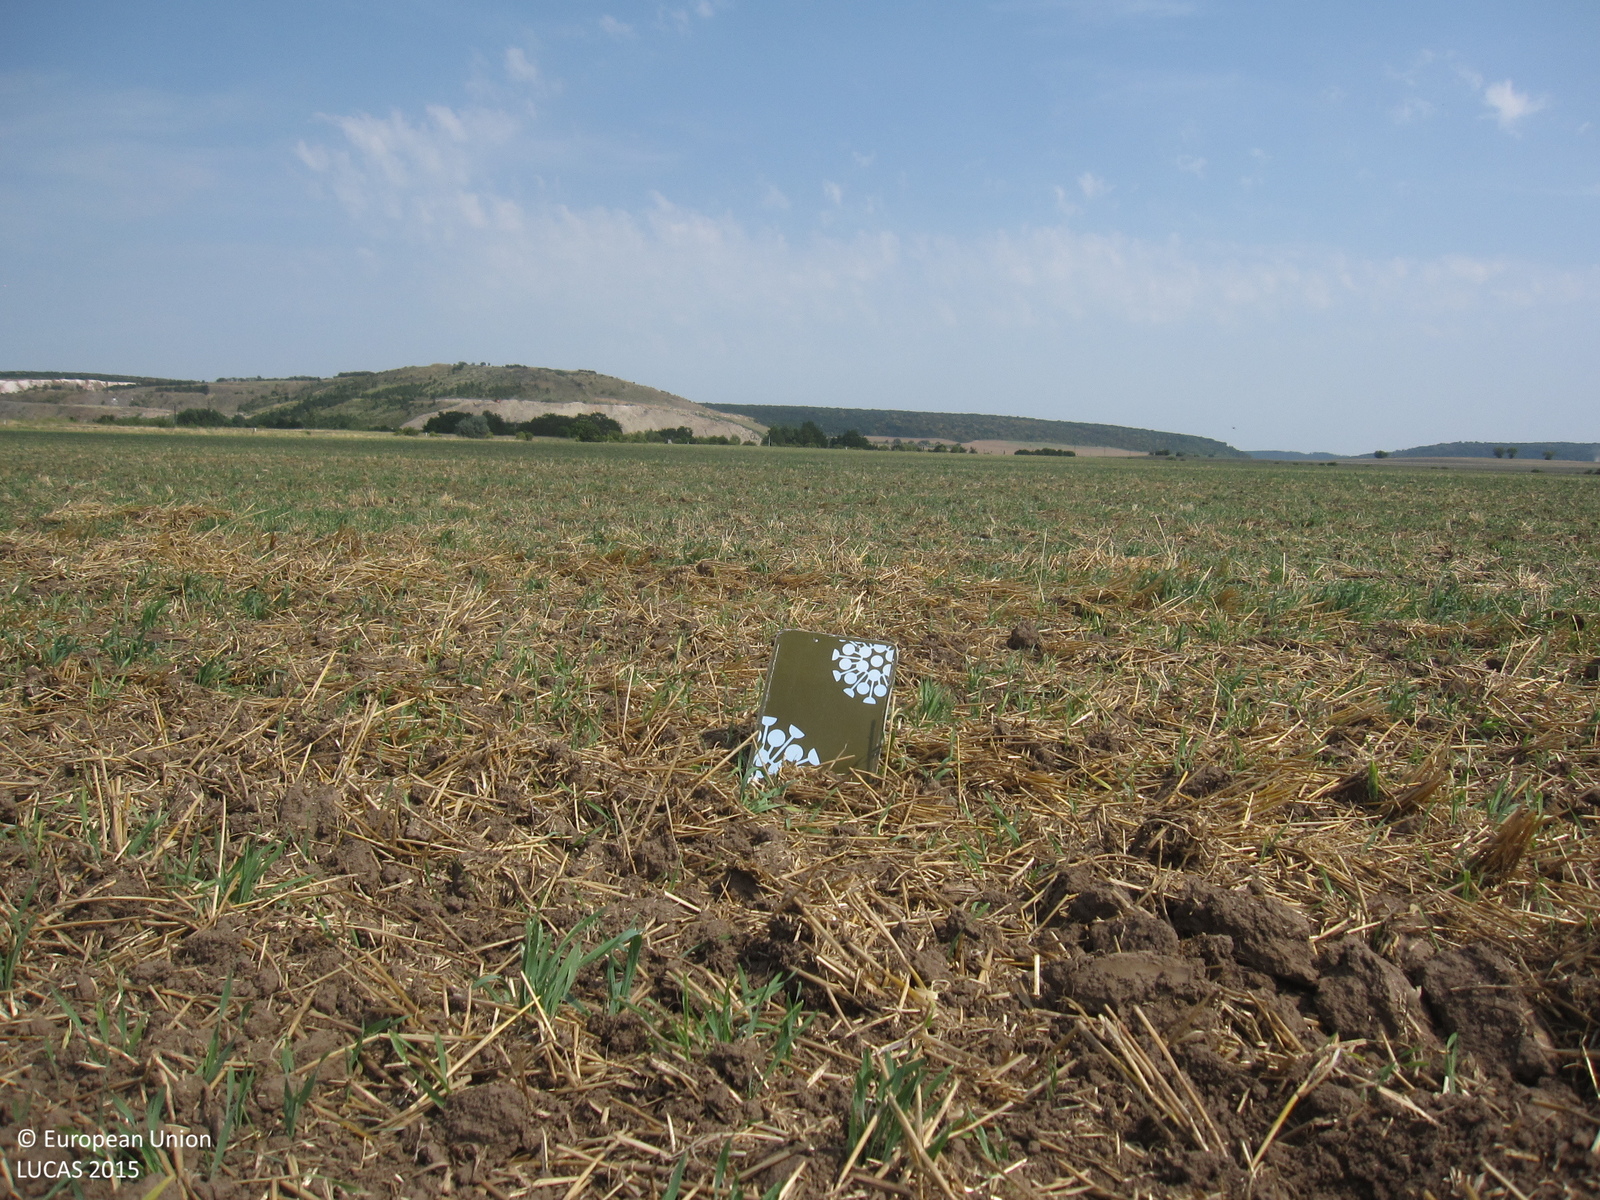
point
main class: Cropland
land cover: Common wheat
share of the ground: 10 - 25 %
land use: Agriculture (excluding fallow land and kitchen gardens)
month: August
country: DE
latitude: 51.2899
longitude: 11.4479
